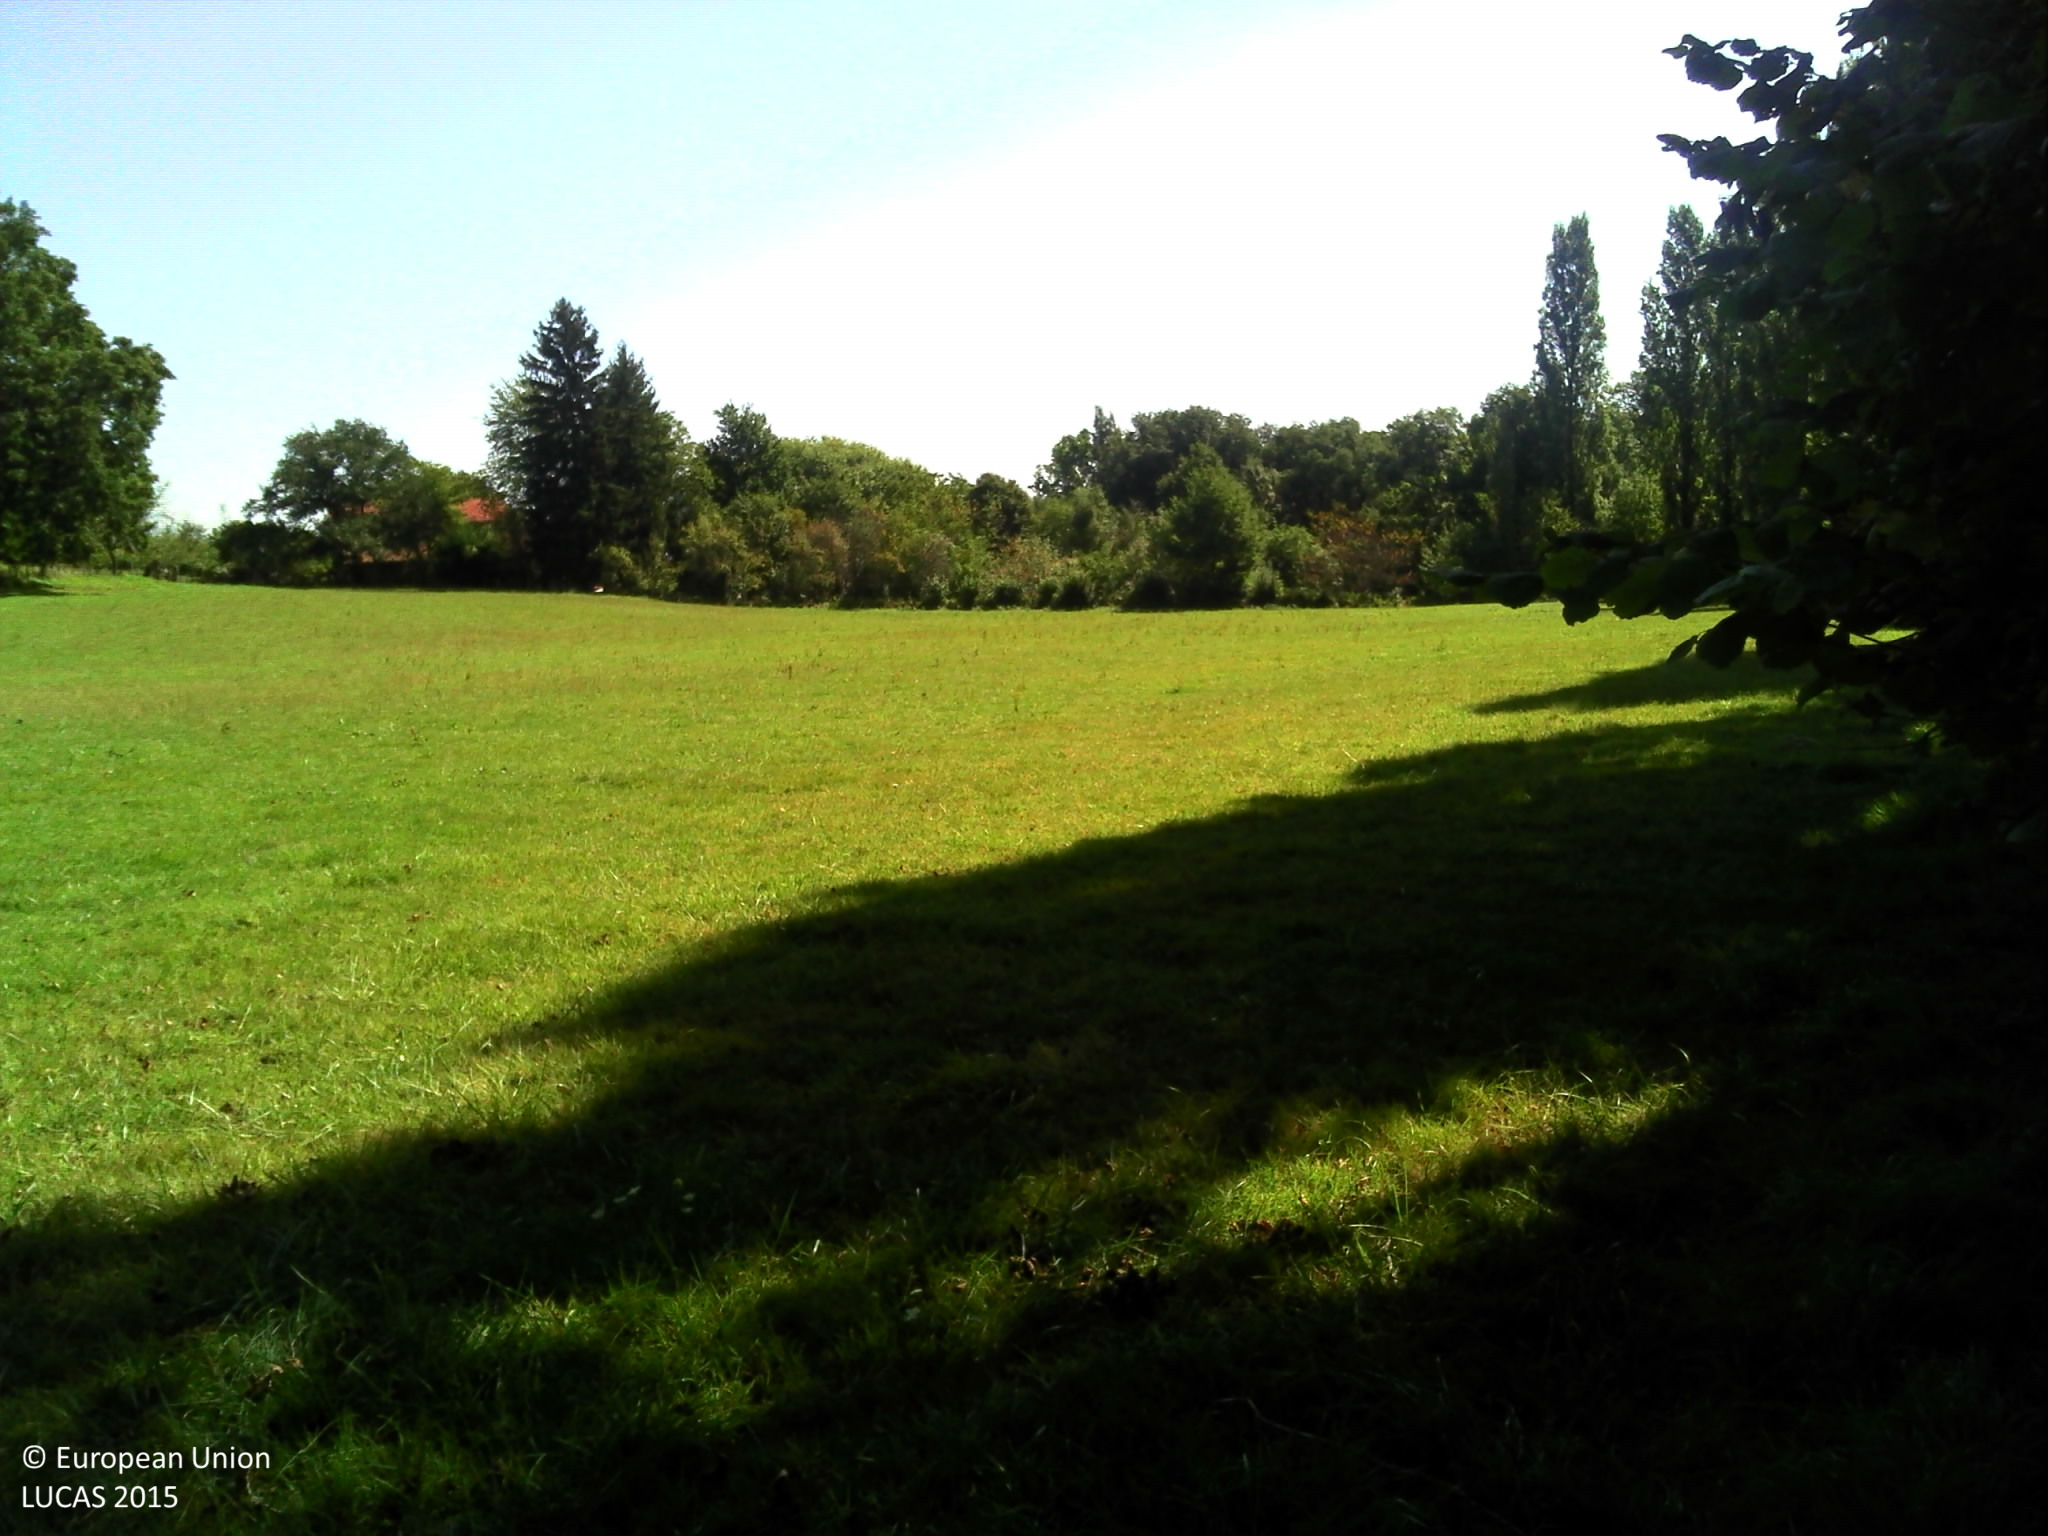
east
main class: Grassland
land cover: Grassland without tree/shrub cover
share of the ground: > 75 %
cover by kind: herbaceous plants 100 %
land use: Agriculture (excluding fallow land and kitchen gardens)
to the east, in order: Grassland without tree/shrub cover; Fences; Dry stone walls; Broadleaved woodland; Dry stone walls; Fences; Broadleaved woodland; Tracks; Broadleaved woodland; Electric lines; Broadleaved woodland; Fences; Broadleaved woodland; Electric lines; Broadleaved woodland
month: September
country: FR
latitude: 43.2453
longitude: -1.0845
